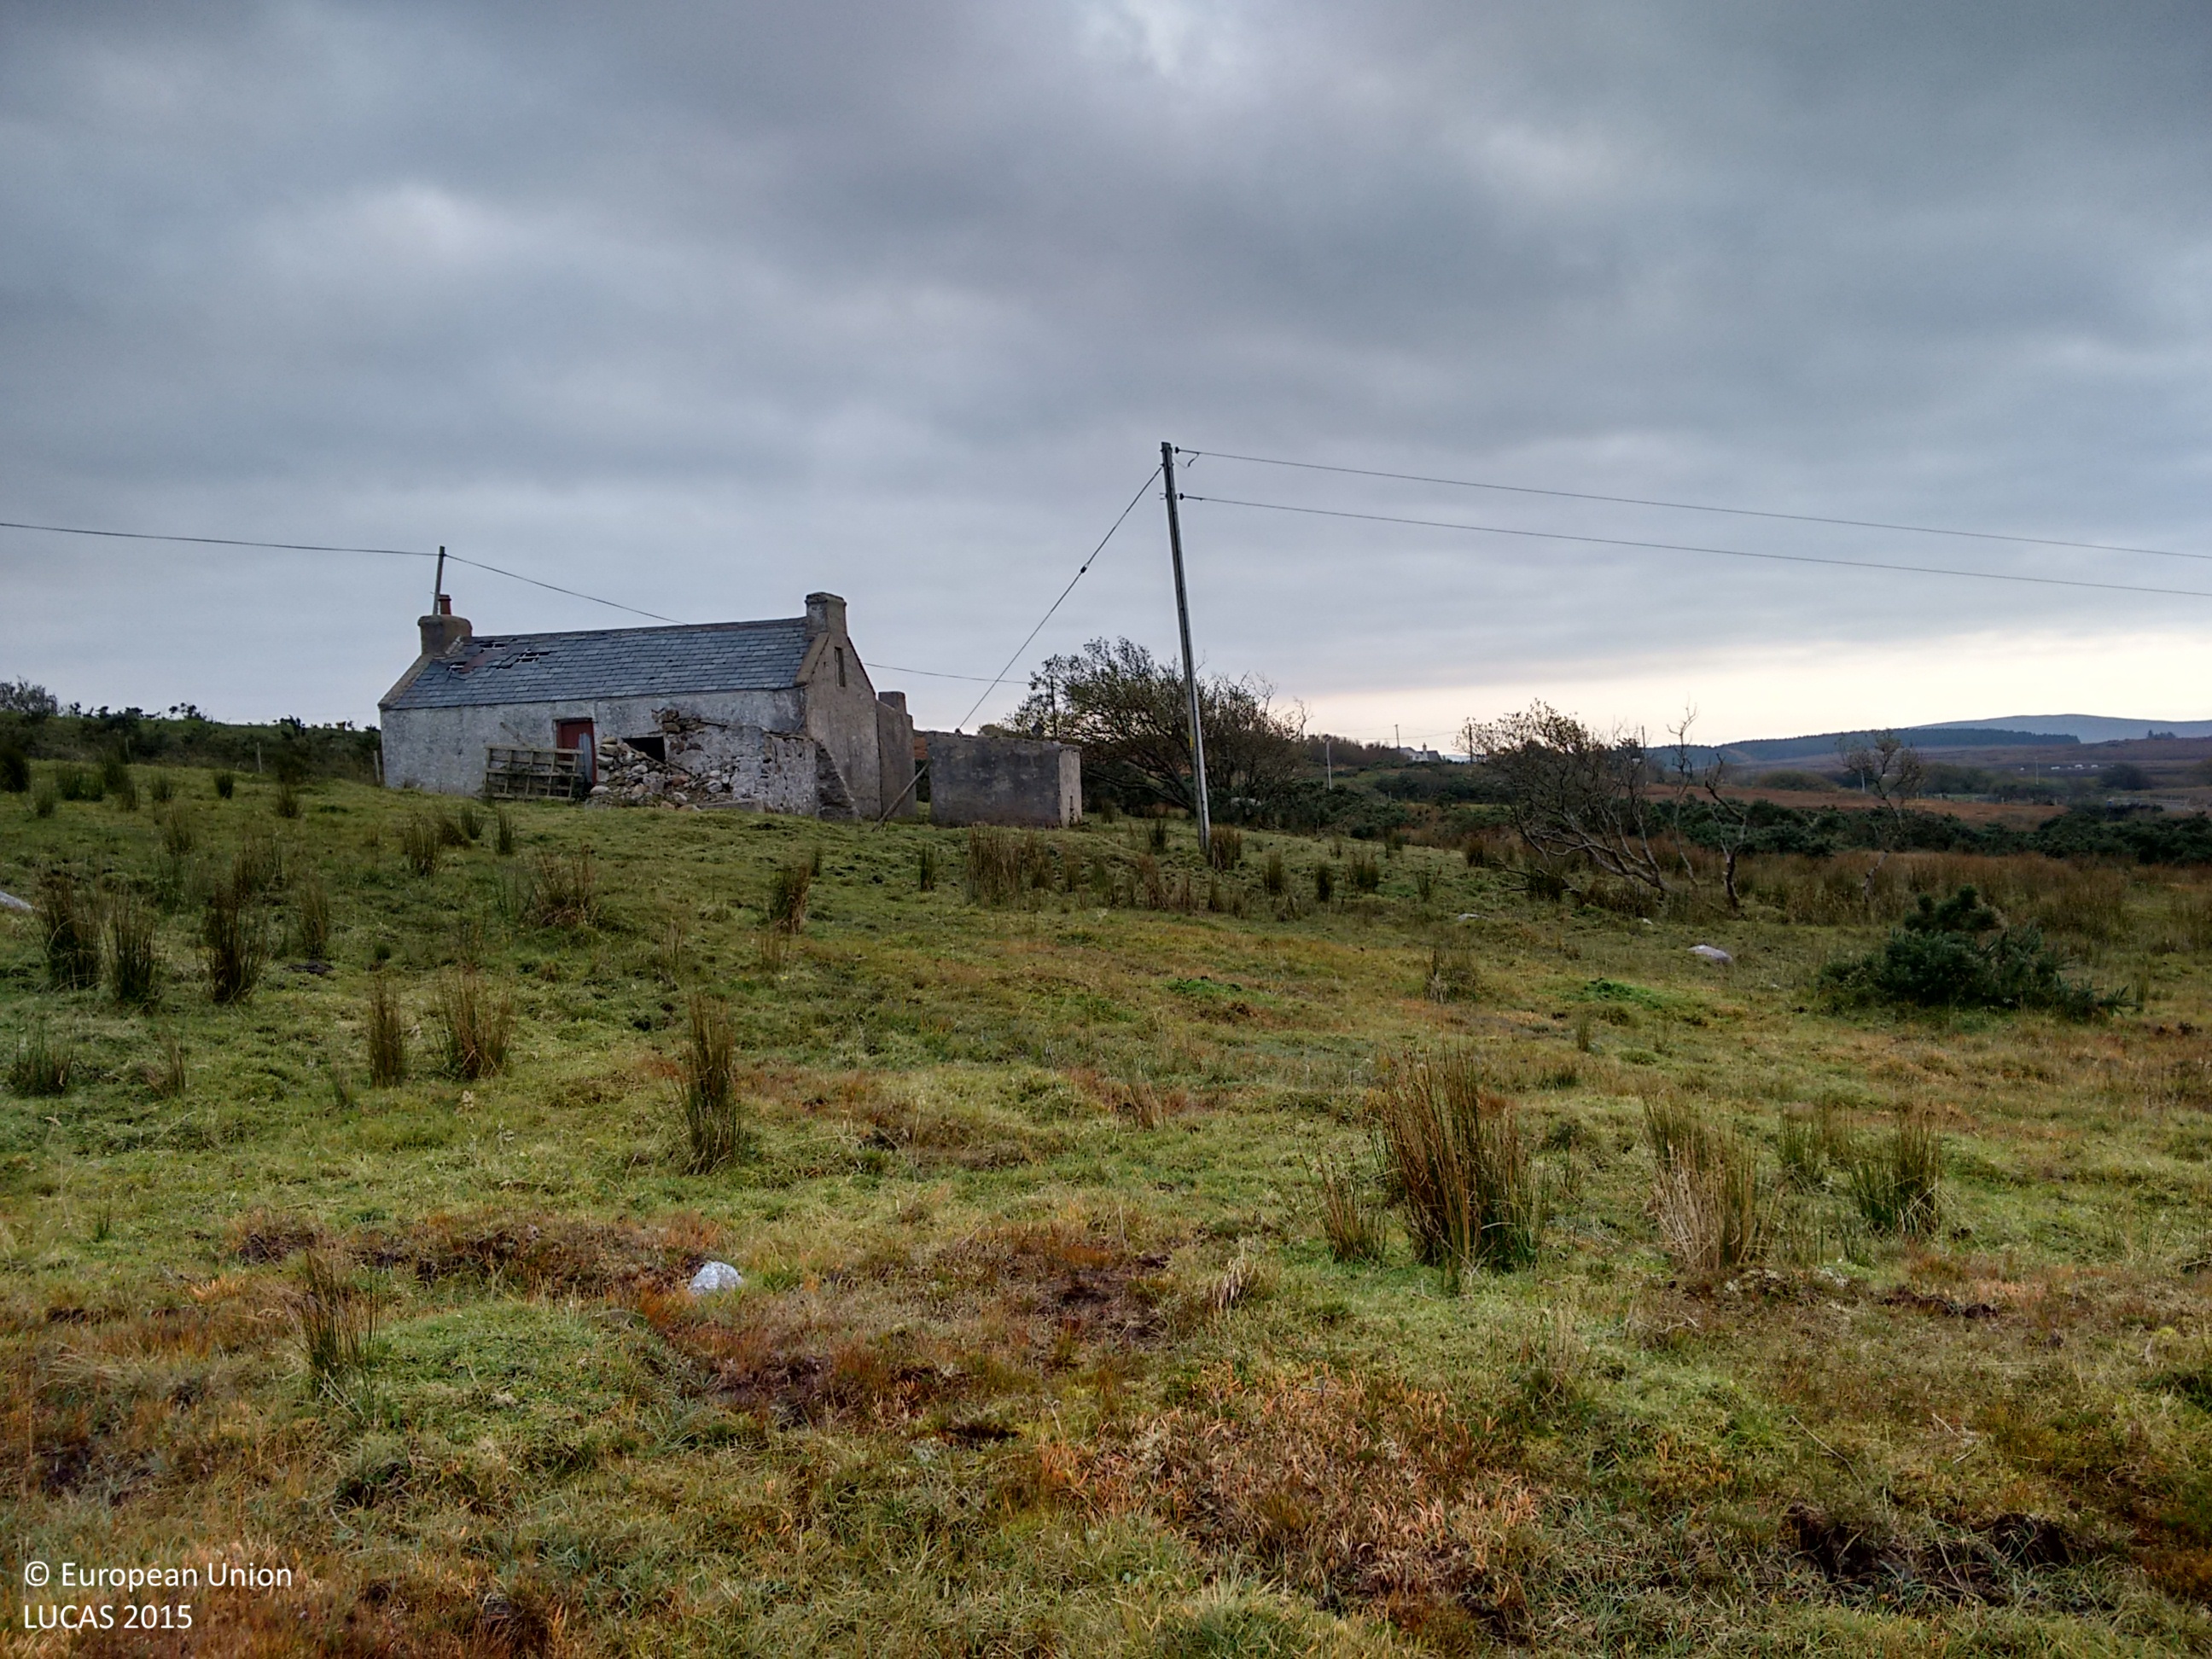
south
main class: Grassland
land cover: Grassland without tree/shrub cover
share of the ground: > 75 %
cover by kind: herbaceous plants 70 %, lichens and mosses 30 %
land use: Agriculture (excluding fallow land and kitchen gardens)
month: November
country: IE
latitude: 54.9796
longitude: -8.3237
